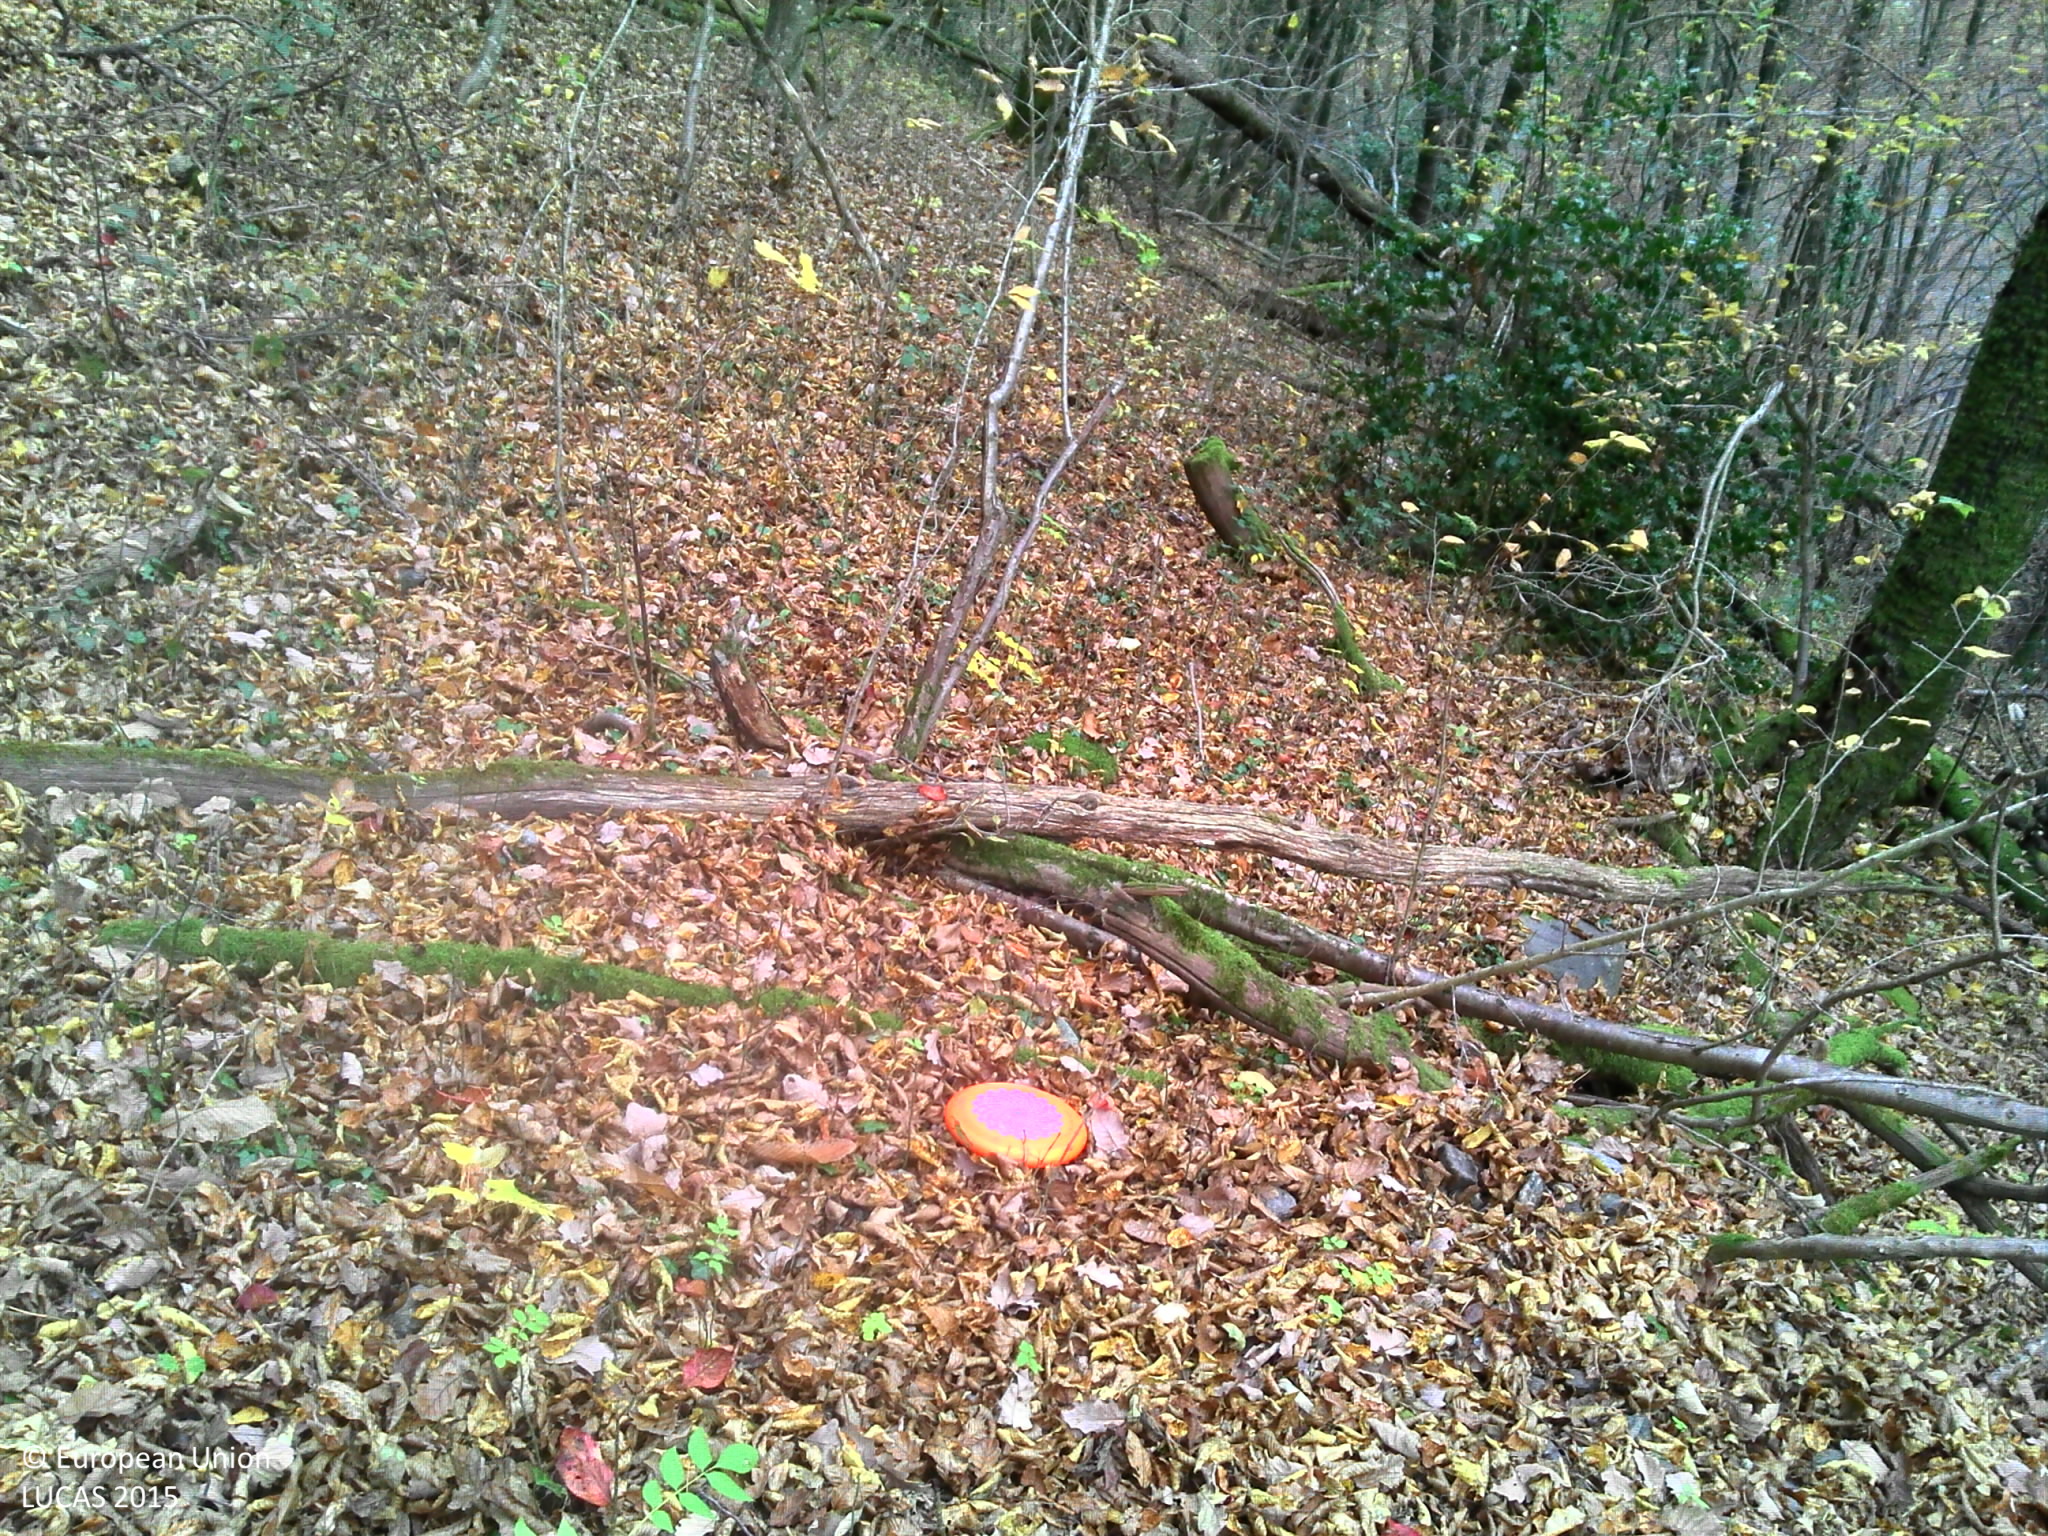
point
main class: Woodland
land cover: Broadleaved woodland
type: mesophytic deciduous forest
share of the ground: > 75 %
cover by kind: broadleaved forest trees 90 %, shrubs 5 %, unconsolidated bare surface 5 %
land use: Forestry
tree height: > 5 m
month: November
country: FR
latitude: 45.6963
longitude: 6.4213
